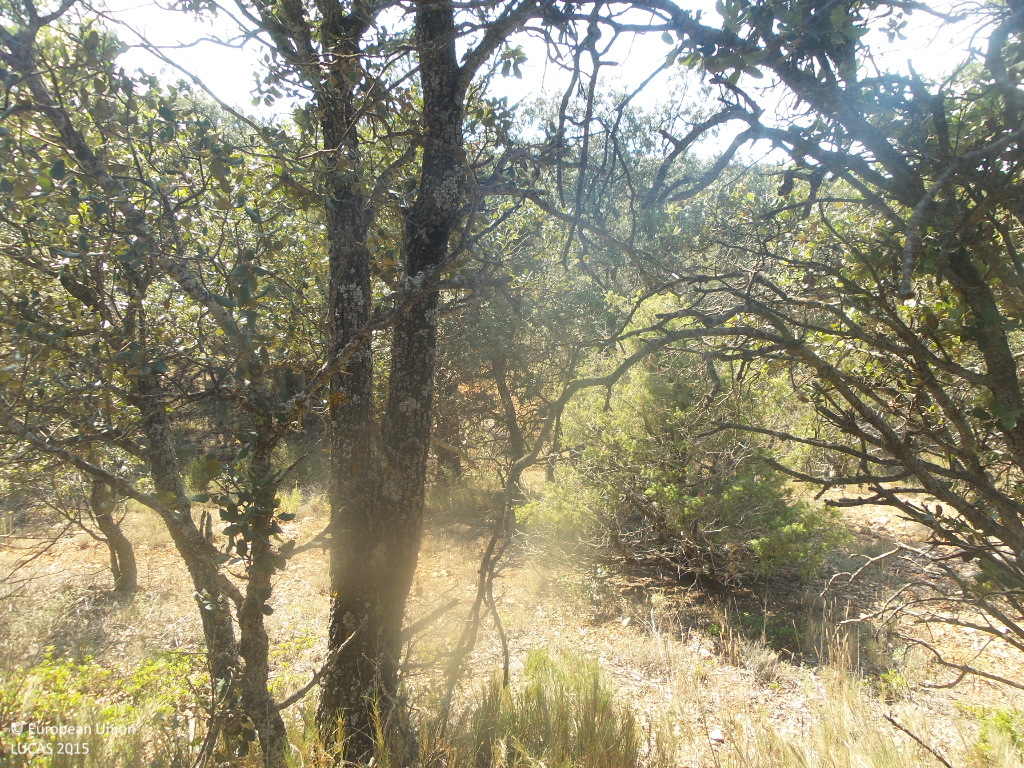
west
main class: Woodland
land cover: Other mixed woodland
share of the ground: 50 - 75 %
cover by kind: coniferous forest trees 40 %, broadleaved forest trees 20 %, shrubs 20 %, herbaceous plants 10 %, unconsolidated bare surface 10 %
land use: Semi-natural and natural areas not in use
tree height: < 5 m
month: July
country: ES
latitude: 41.1594
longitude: -2.0998
